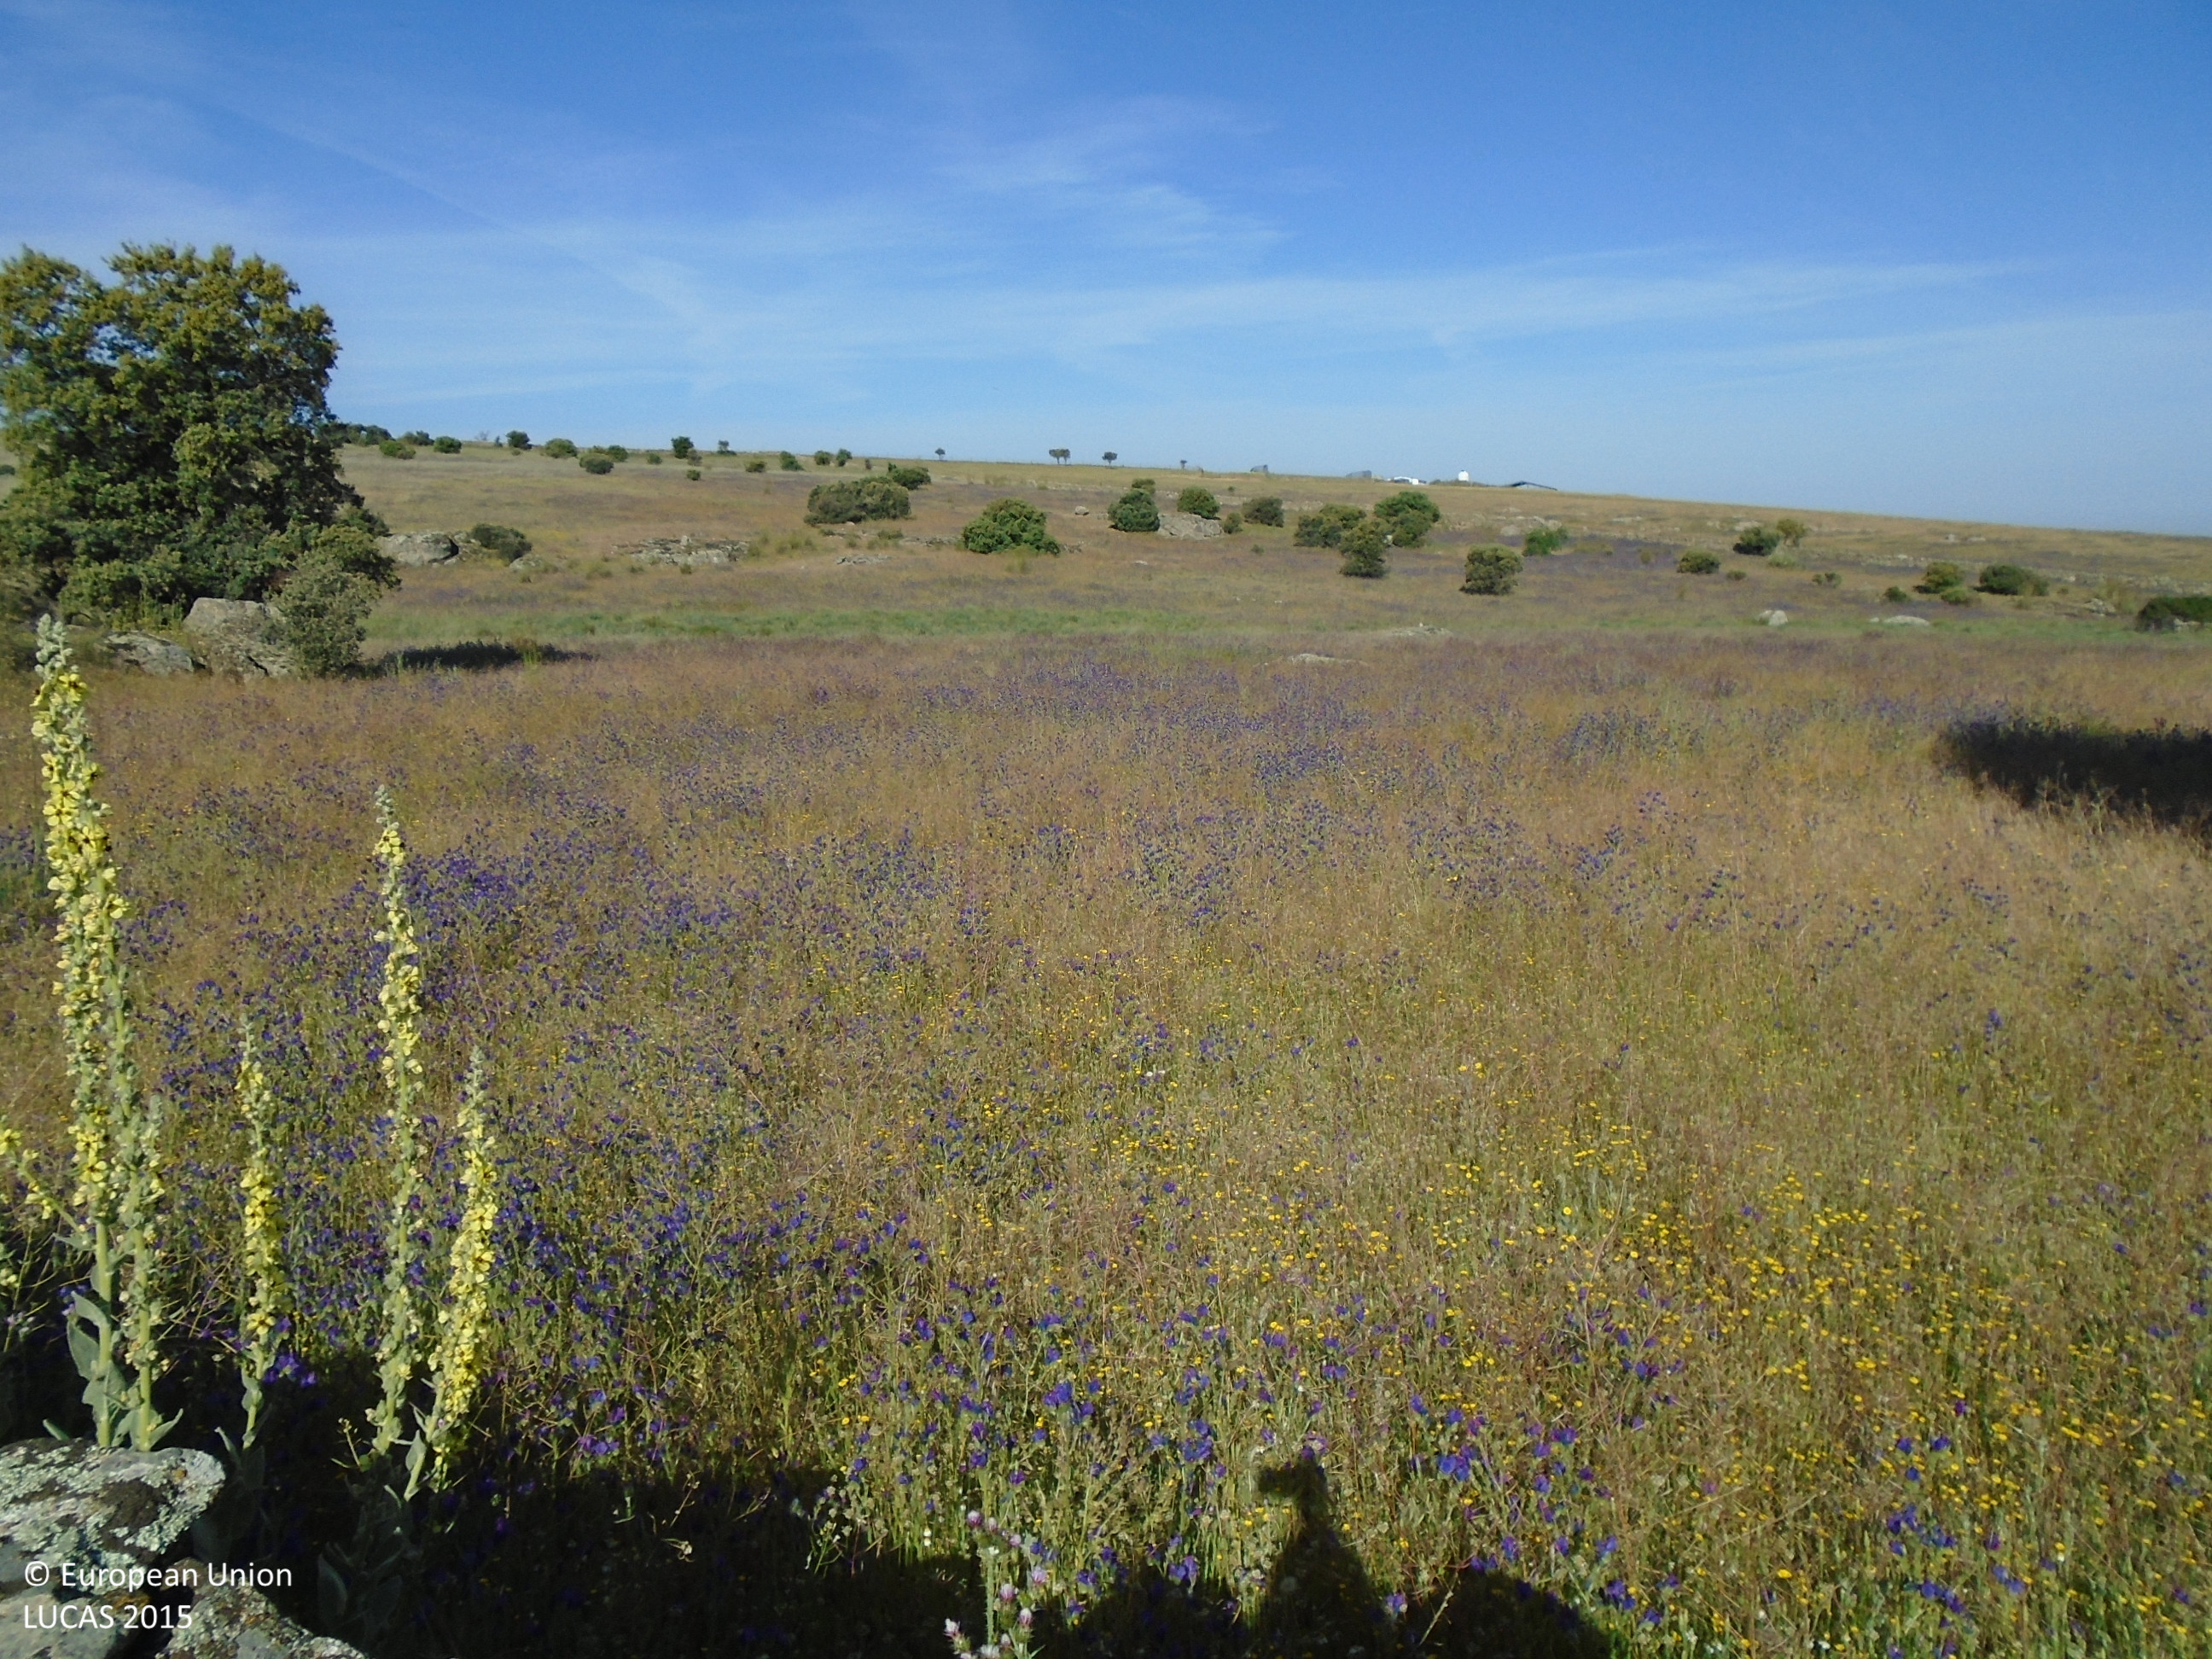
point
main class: Grassland
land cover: Grassland without tree/shrub cover
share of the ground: > 75 %
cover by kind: herbaceous plants 95 %, consolidated bare surface 5 %
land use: Agriculture (excluding fallow land and kitchen gardens)
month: May
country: ES
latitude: 39.5914
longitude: -4.2276
